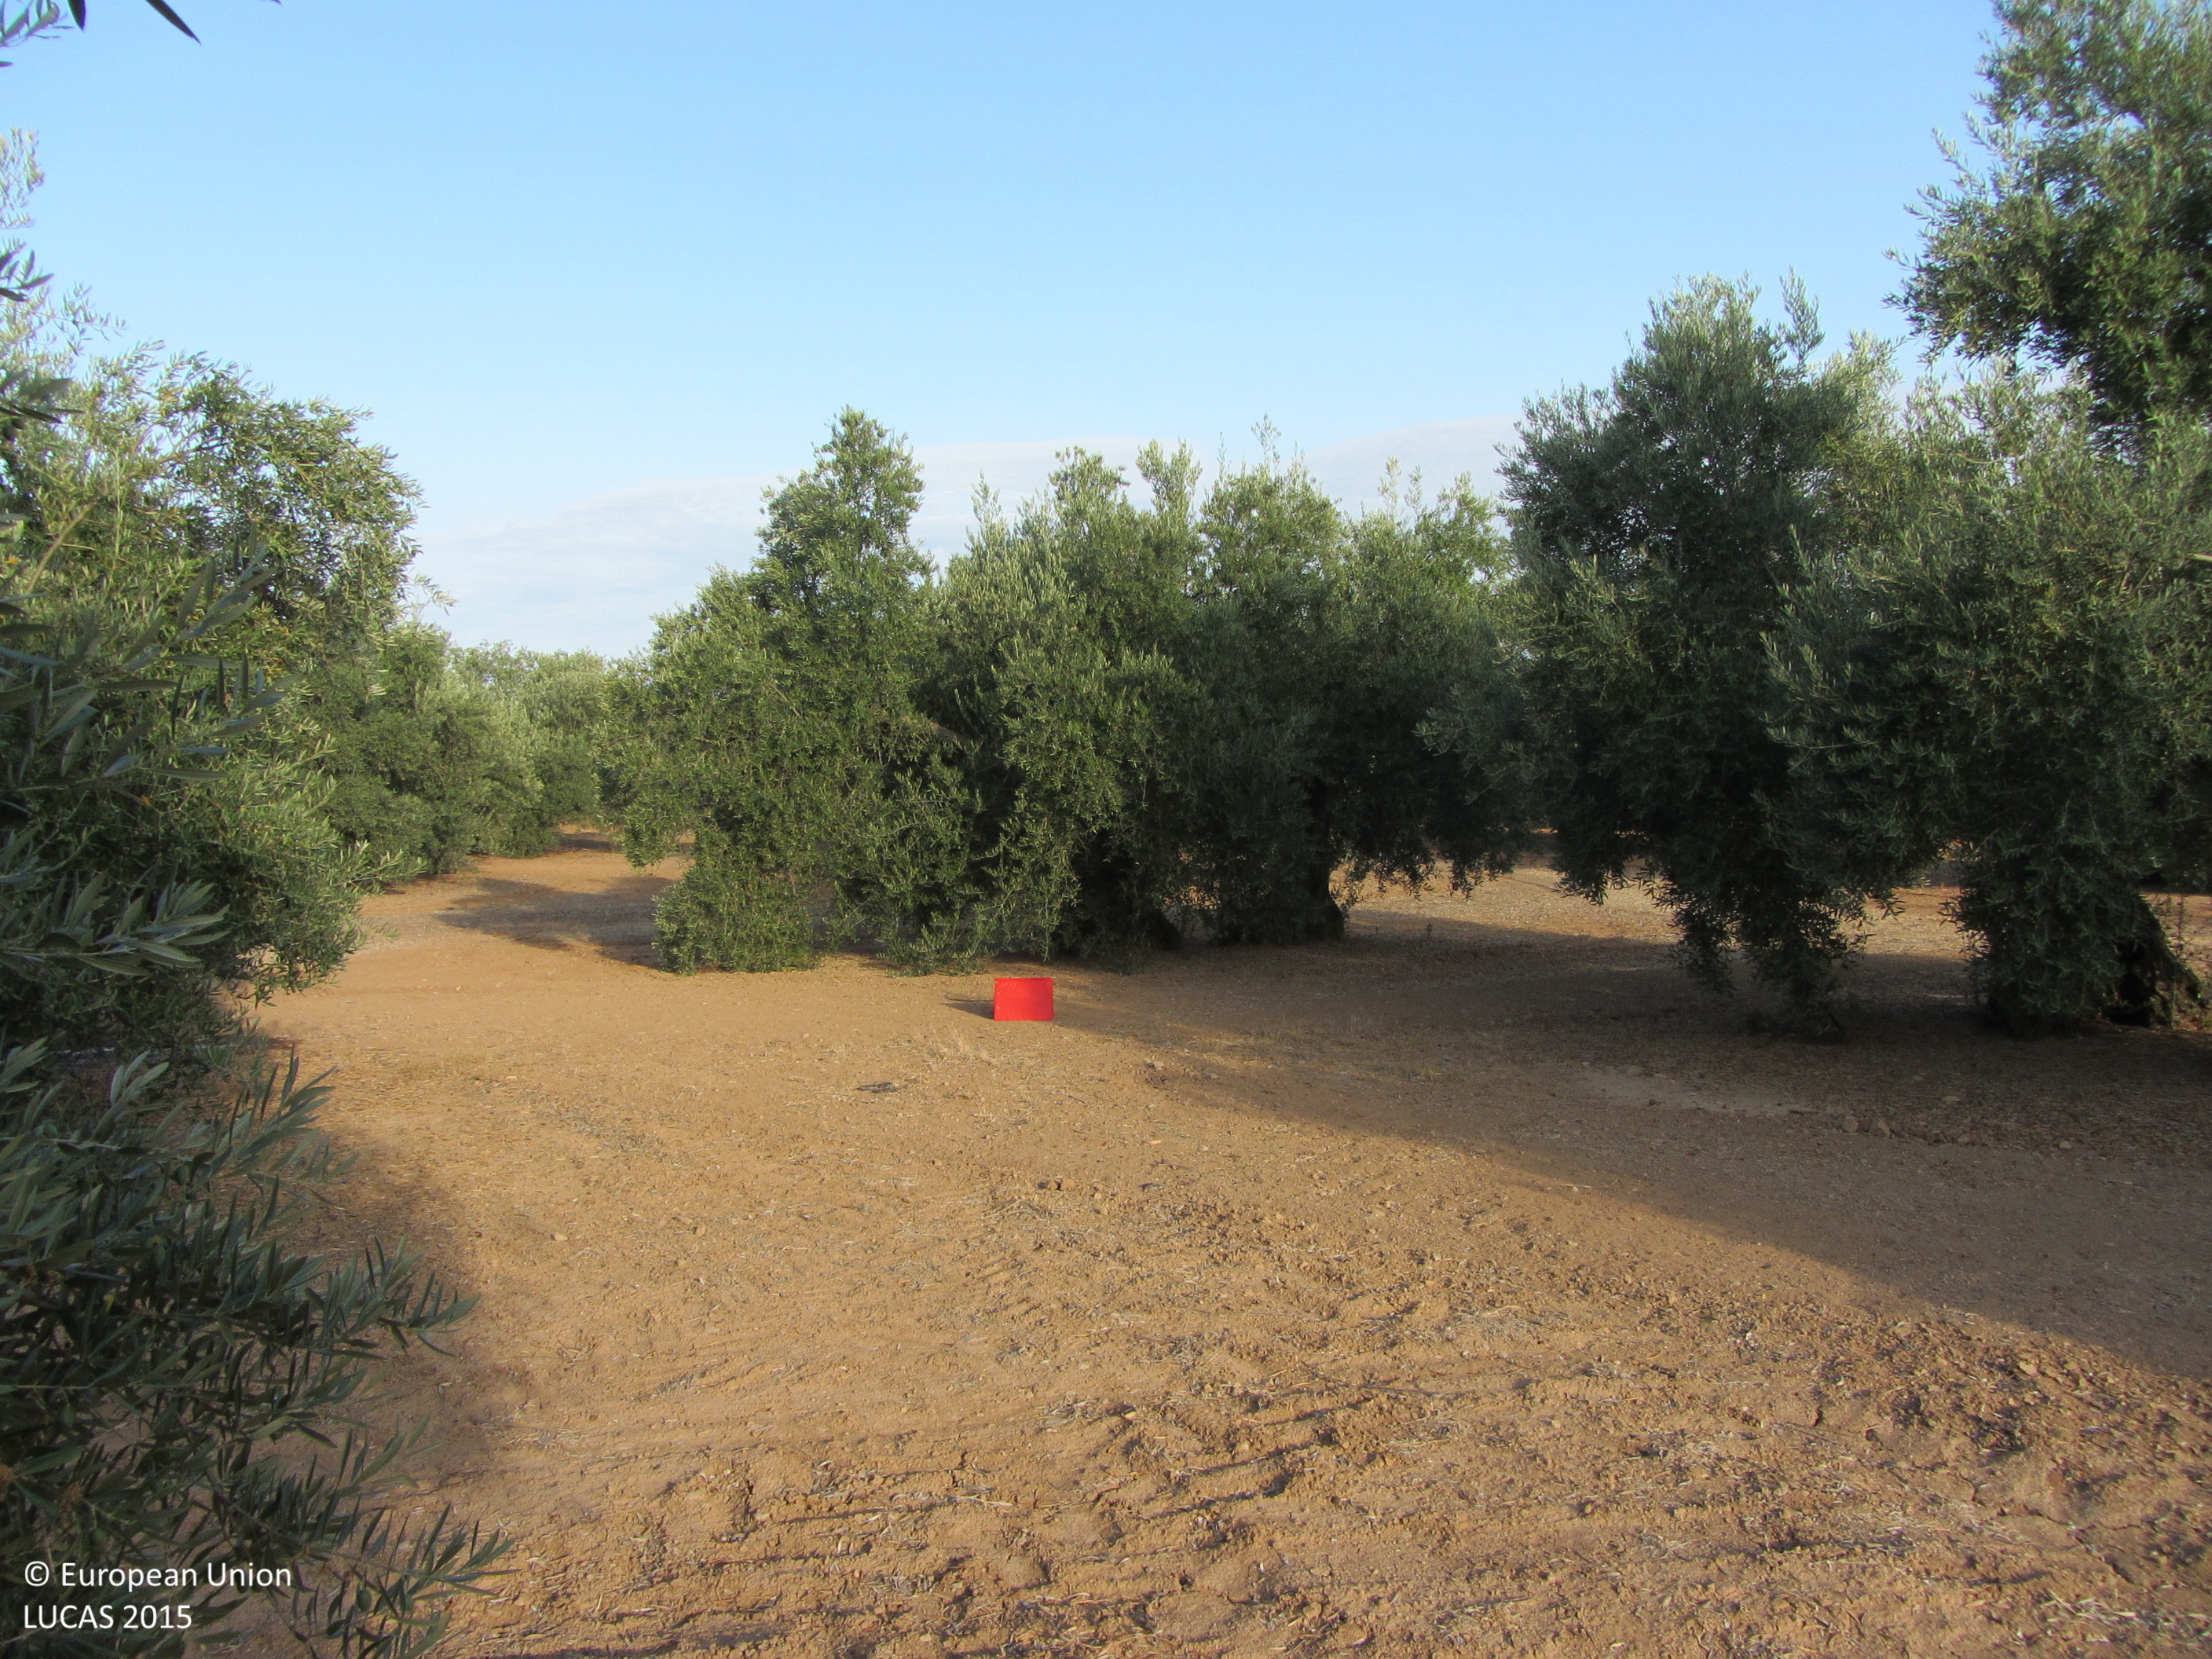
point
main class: Cropland
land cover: Olive groves
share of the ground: 25 - 50 %
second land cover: Other bare soil
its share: > 75 %
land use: Agriculture (excluding fallow land and kitchen gardens)
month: July
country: ES
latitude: 38.0406
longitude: -3.4119
